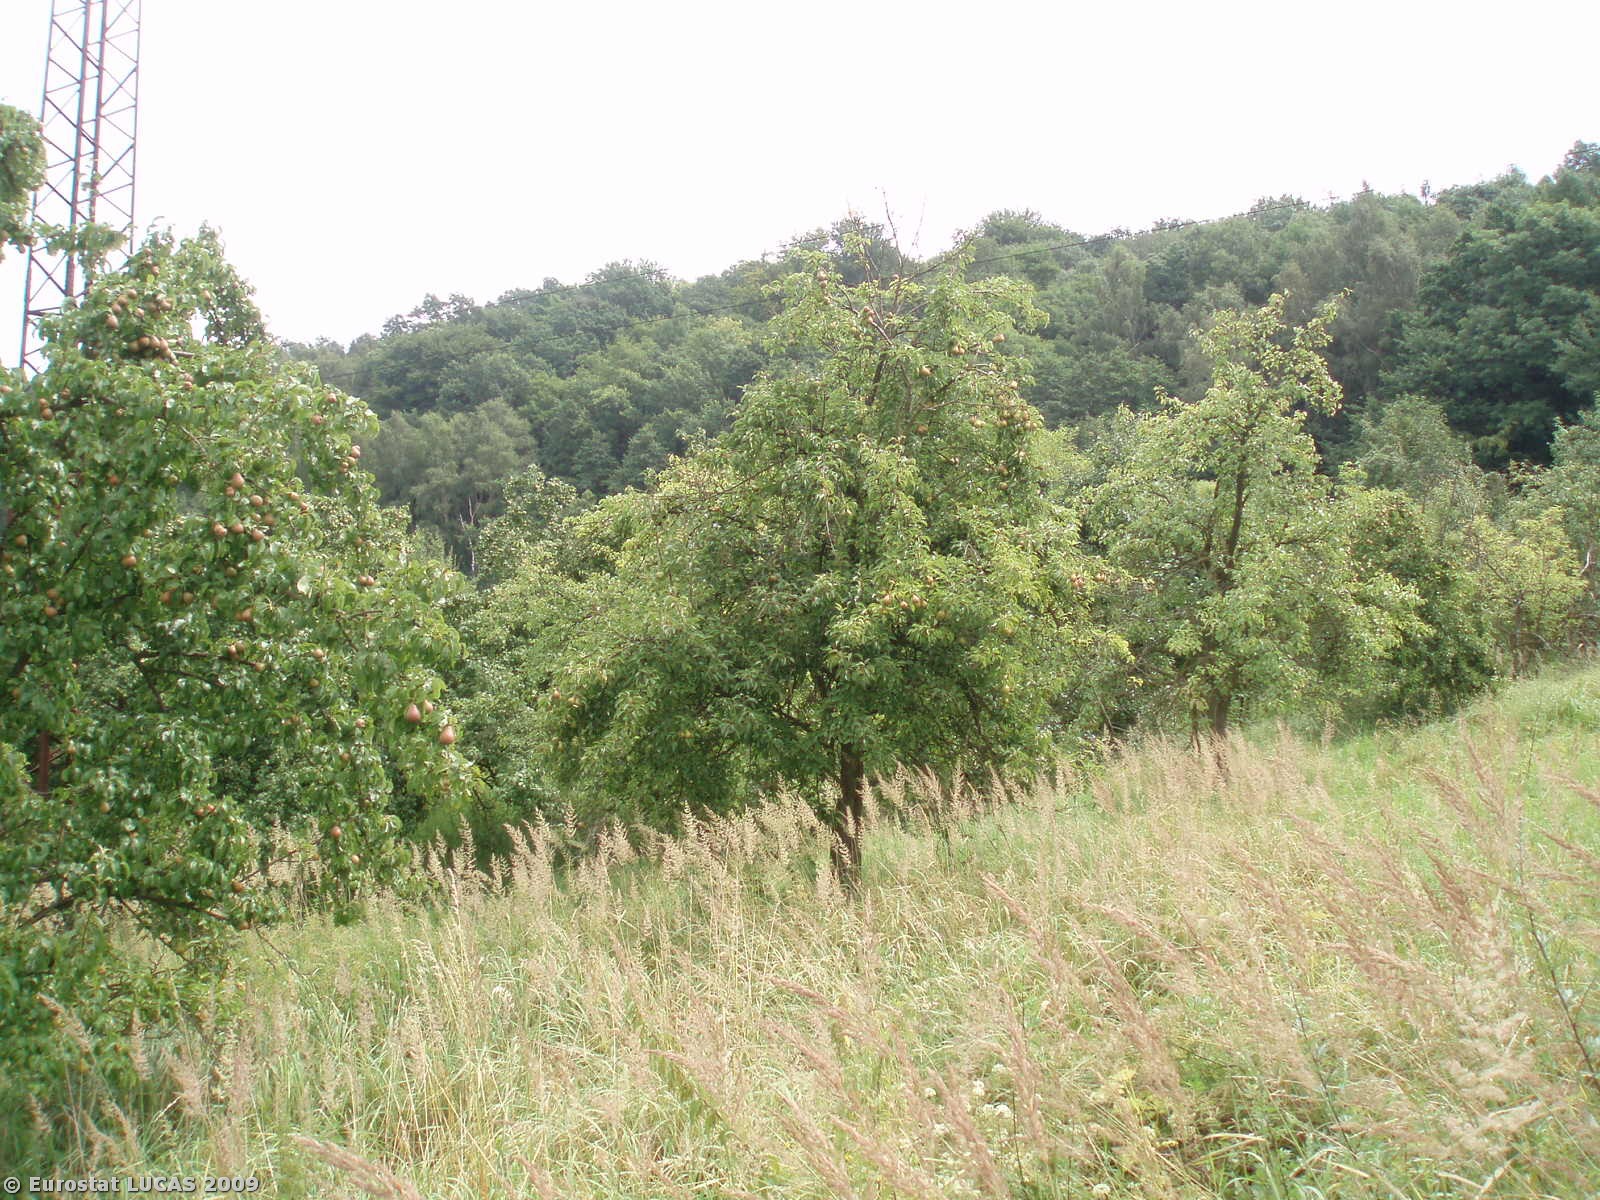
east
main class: Cropland
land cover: Pear fruit
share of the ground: 50 - 75 %
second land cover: Grassland with sparse tree/shrub cover
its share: > 75 %
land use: Agriculture (excluding fallow land and kitchen gardens)
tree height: > 5 m
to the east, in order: Pear fruit; Grassland with sparse tree/shrub cover; Electric lines; Pear fruit; Grassland with sparse tree/shrub cover; Tracks; Grassland without tree/shrub cover; Broadleaved woodland; Rivers and streams; Broadleaved woodland
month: July
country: CZ
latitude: 50.7547
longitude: 14.2113
